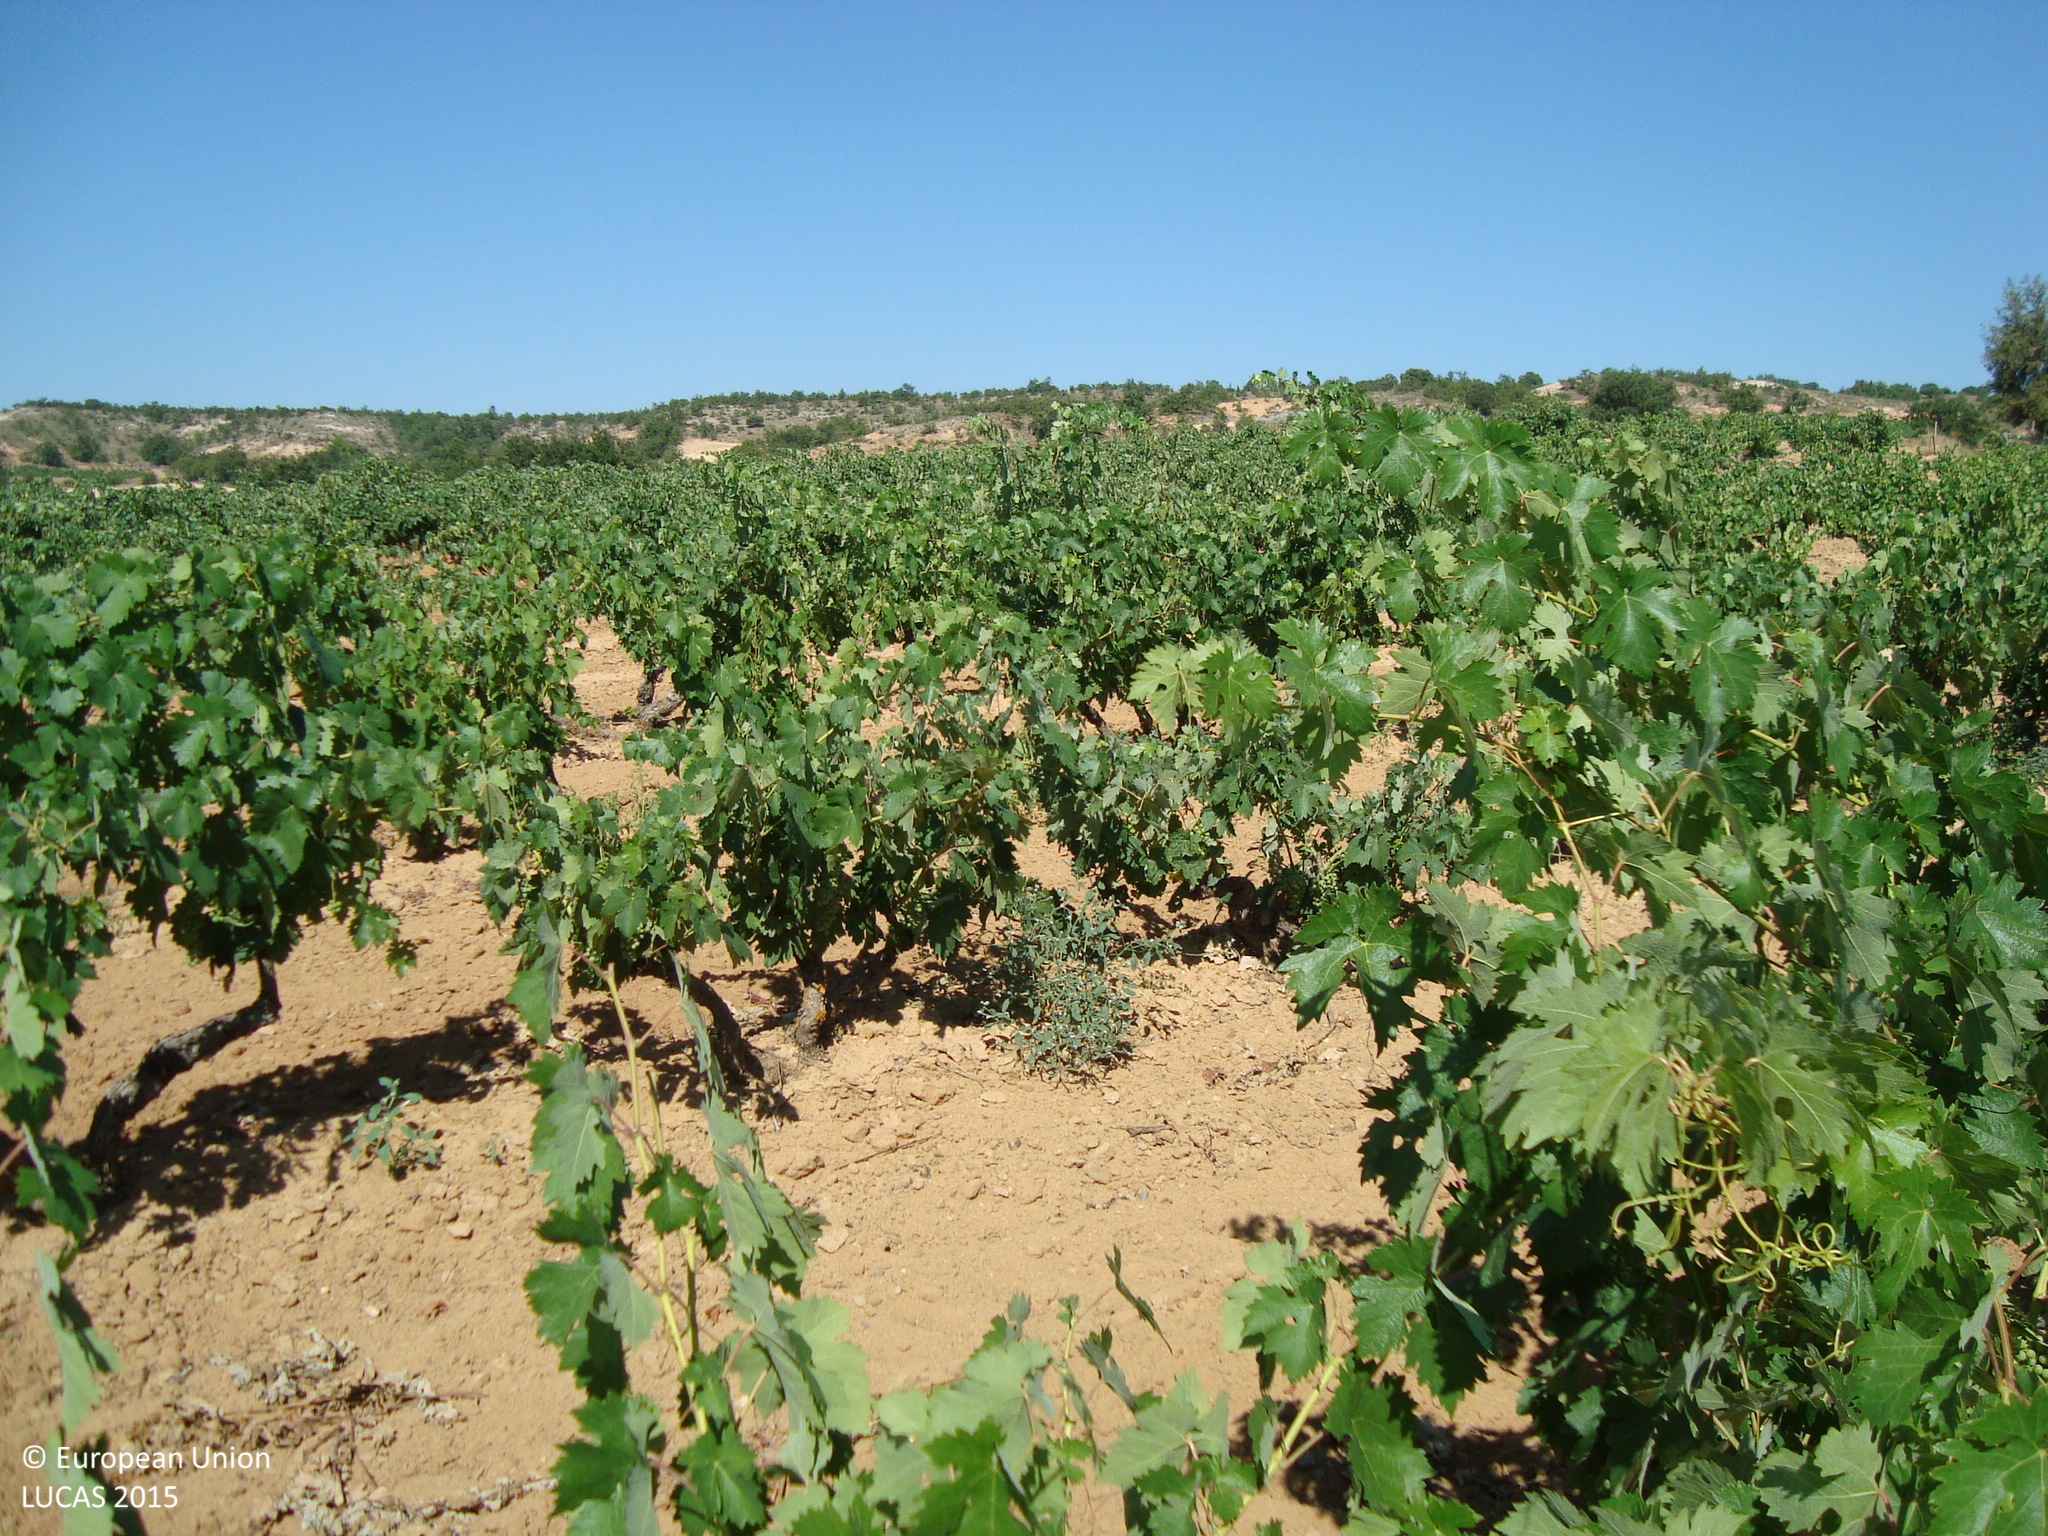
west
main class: Cropland
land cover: Vineyards
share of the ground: 25 - 50 %
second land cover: Other bare soil
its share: > 75 %
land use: Agriculture (excluding fallow land and kitchen gardens)
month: July
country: ES
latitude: 41.7654
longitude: -3.7555
